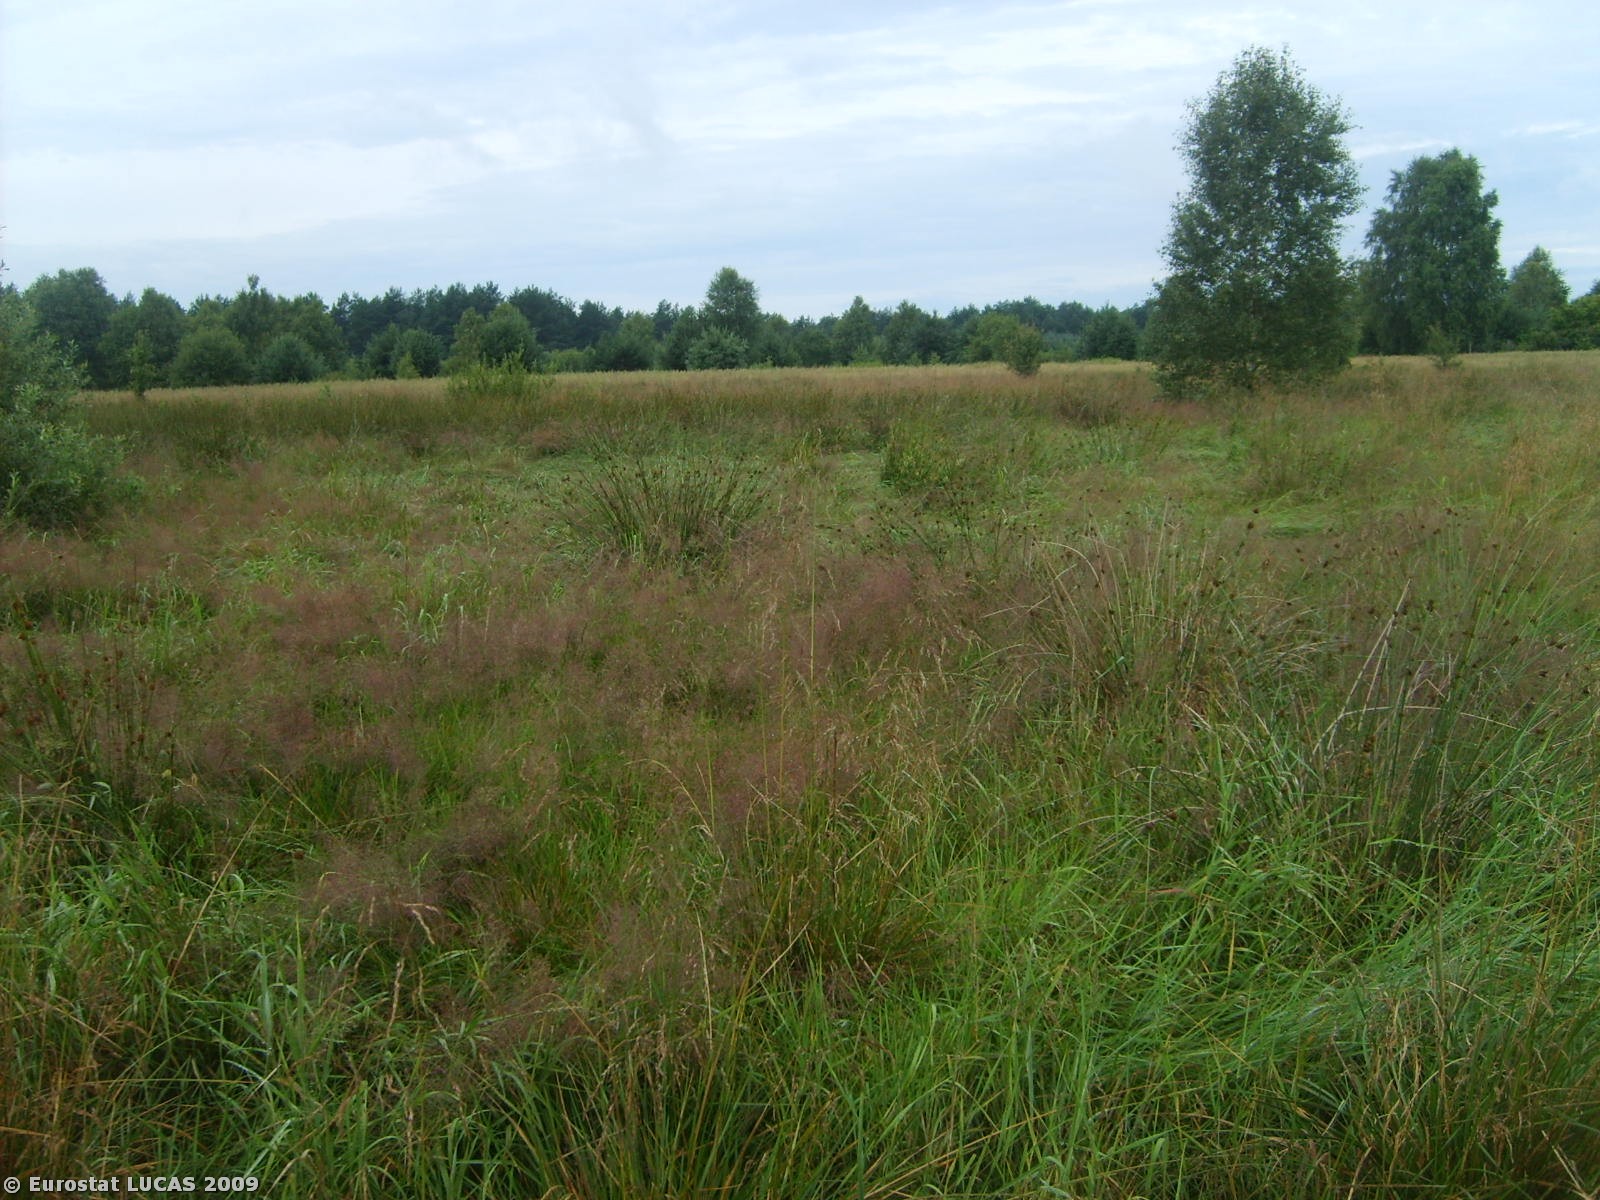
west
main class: Grassland
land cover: Grassland without tree/shrub cover
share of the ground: > 75 %
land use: Agriculture (excluding fallow land and kitchen gardens)
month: July
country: PL
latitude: 52.2950
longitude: 21.6215
